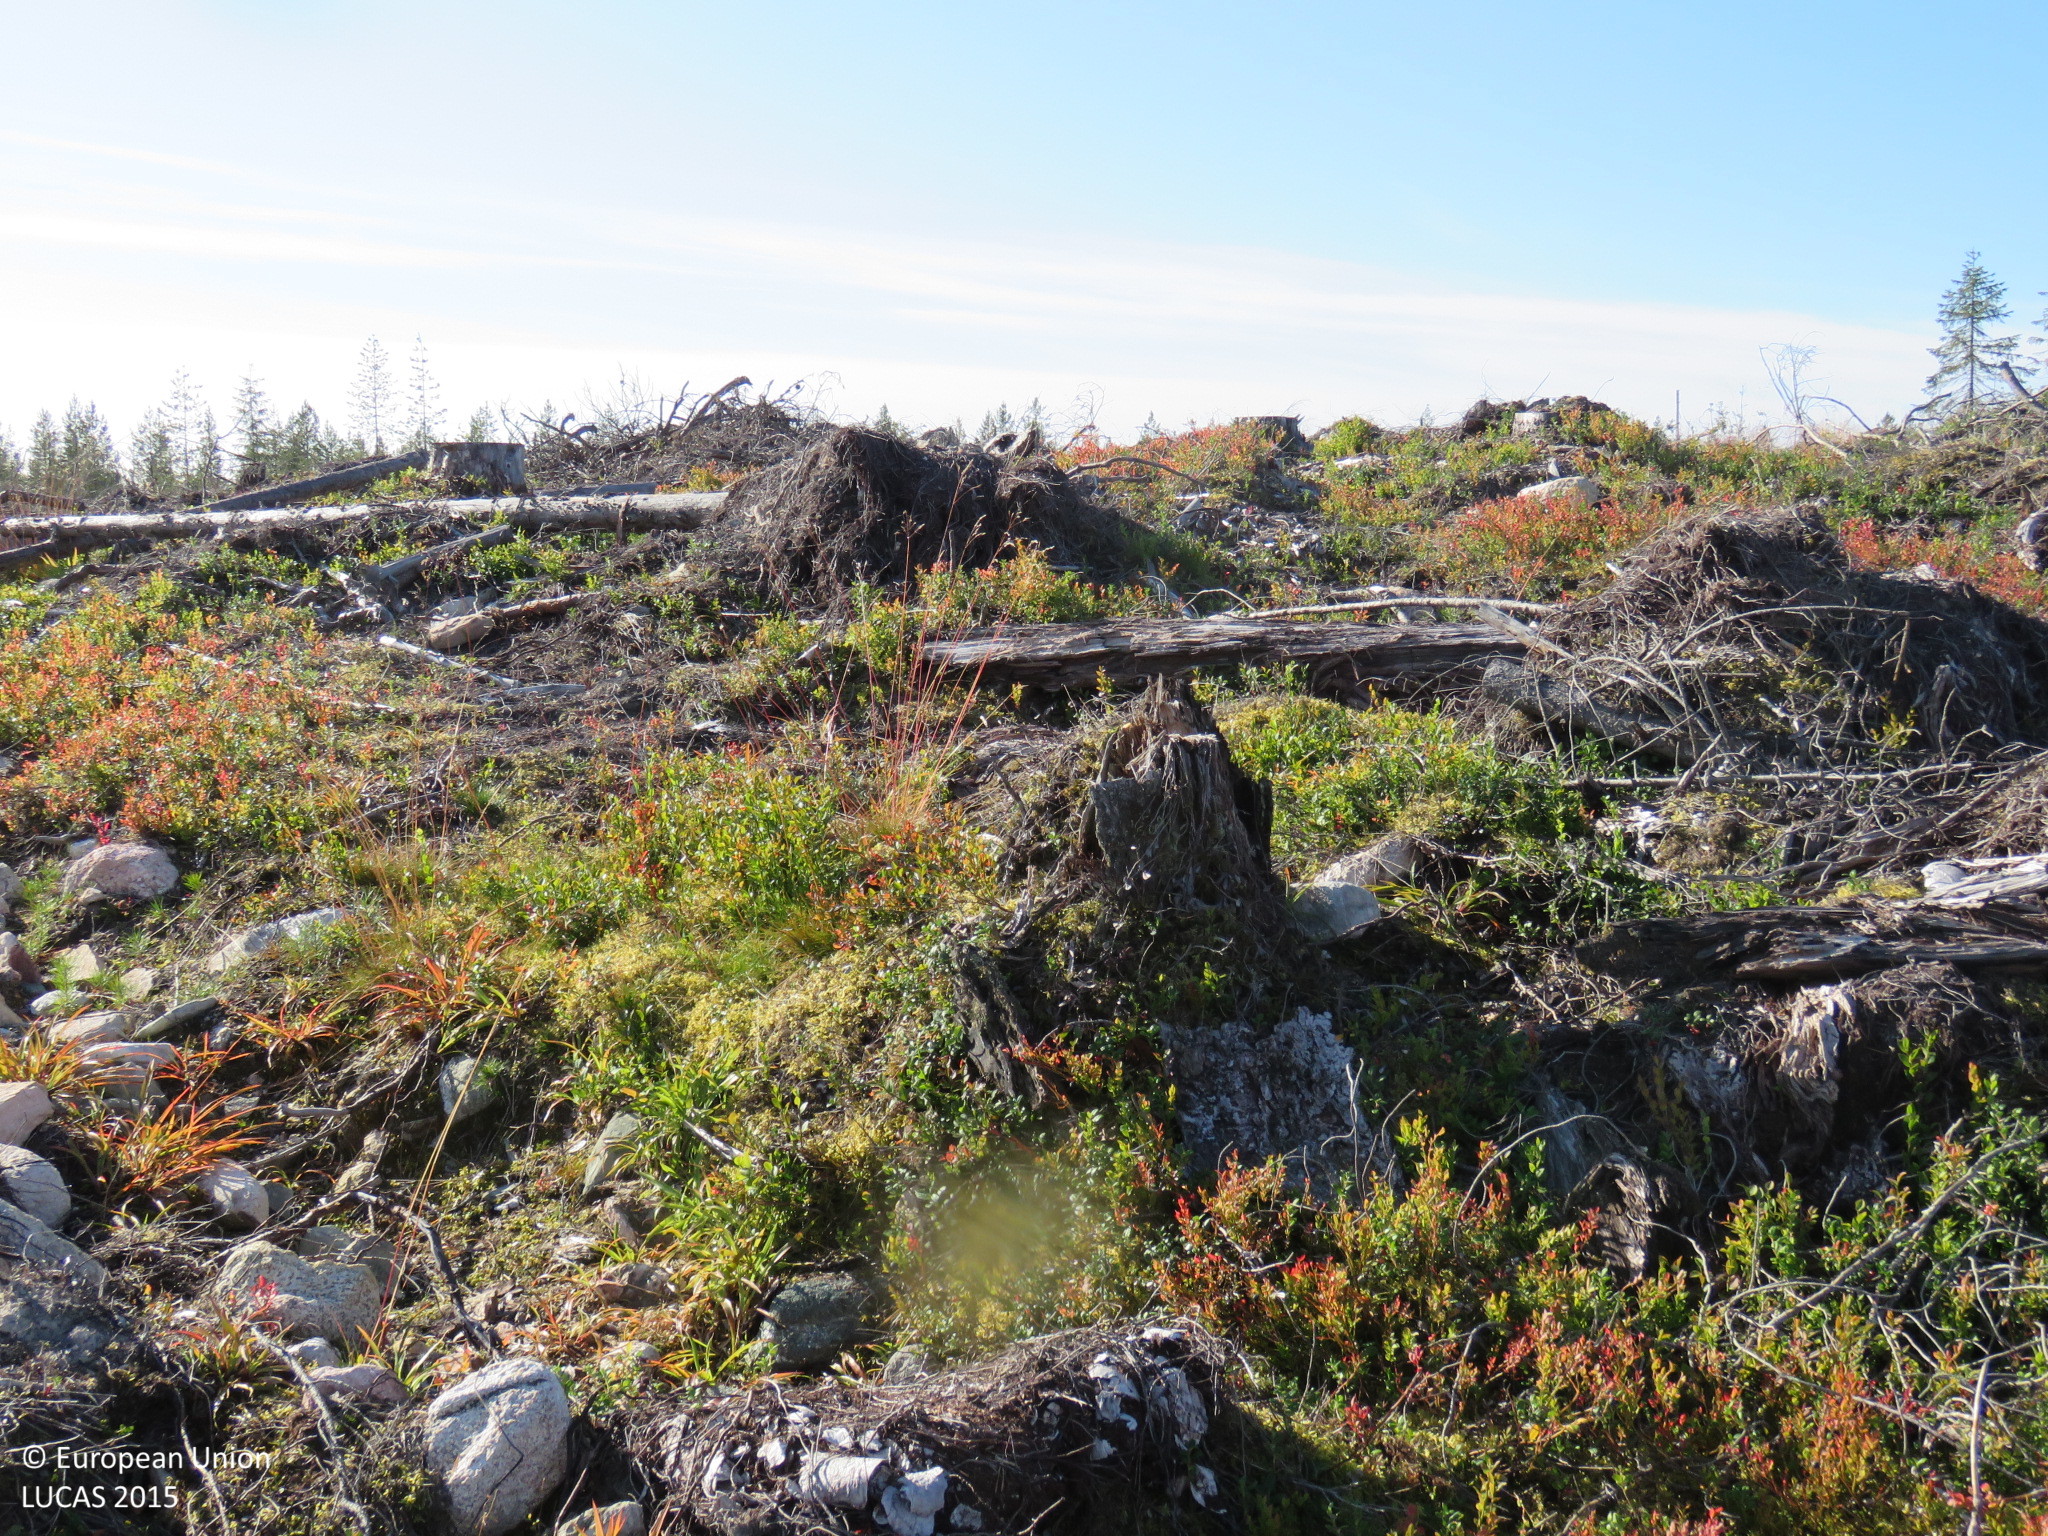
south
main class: Shrubland
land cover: Shrubland with sparse tree cover
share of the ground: 25 - 50 %
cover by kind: shrubs 40 %, consolidated bare surface 20 %, lichens and mosses 15 %, herbaceous plants 10 %, coniferous forest trees 5 %
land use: Forestry
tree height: > 5 m
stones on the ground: 10 - 25 %
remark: Clear cut
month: September
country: FI
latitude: 65.5048
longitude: 27.6195
